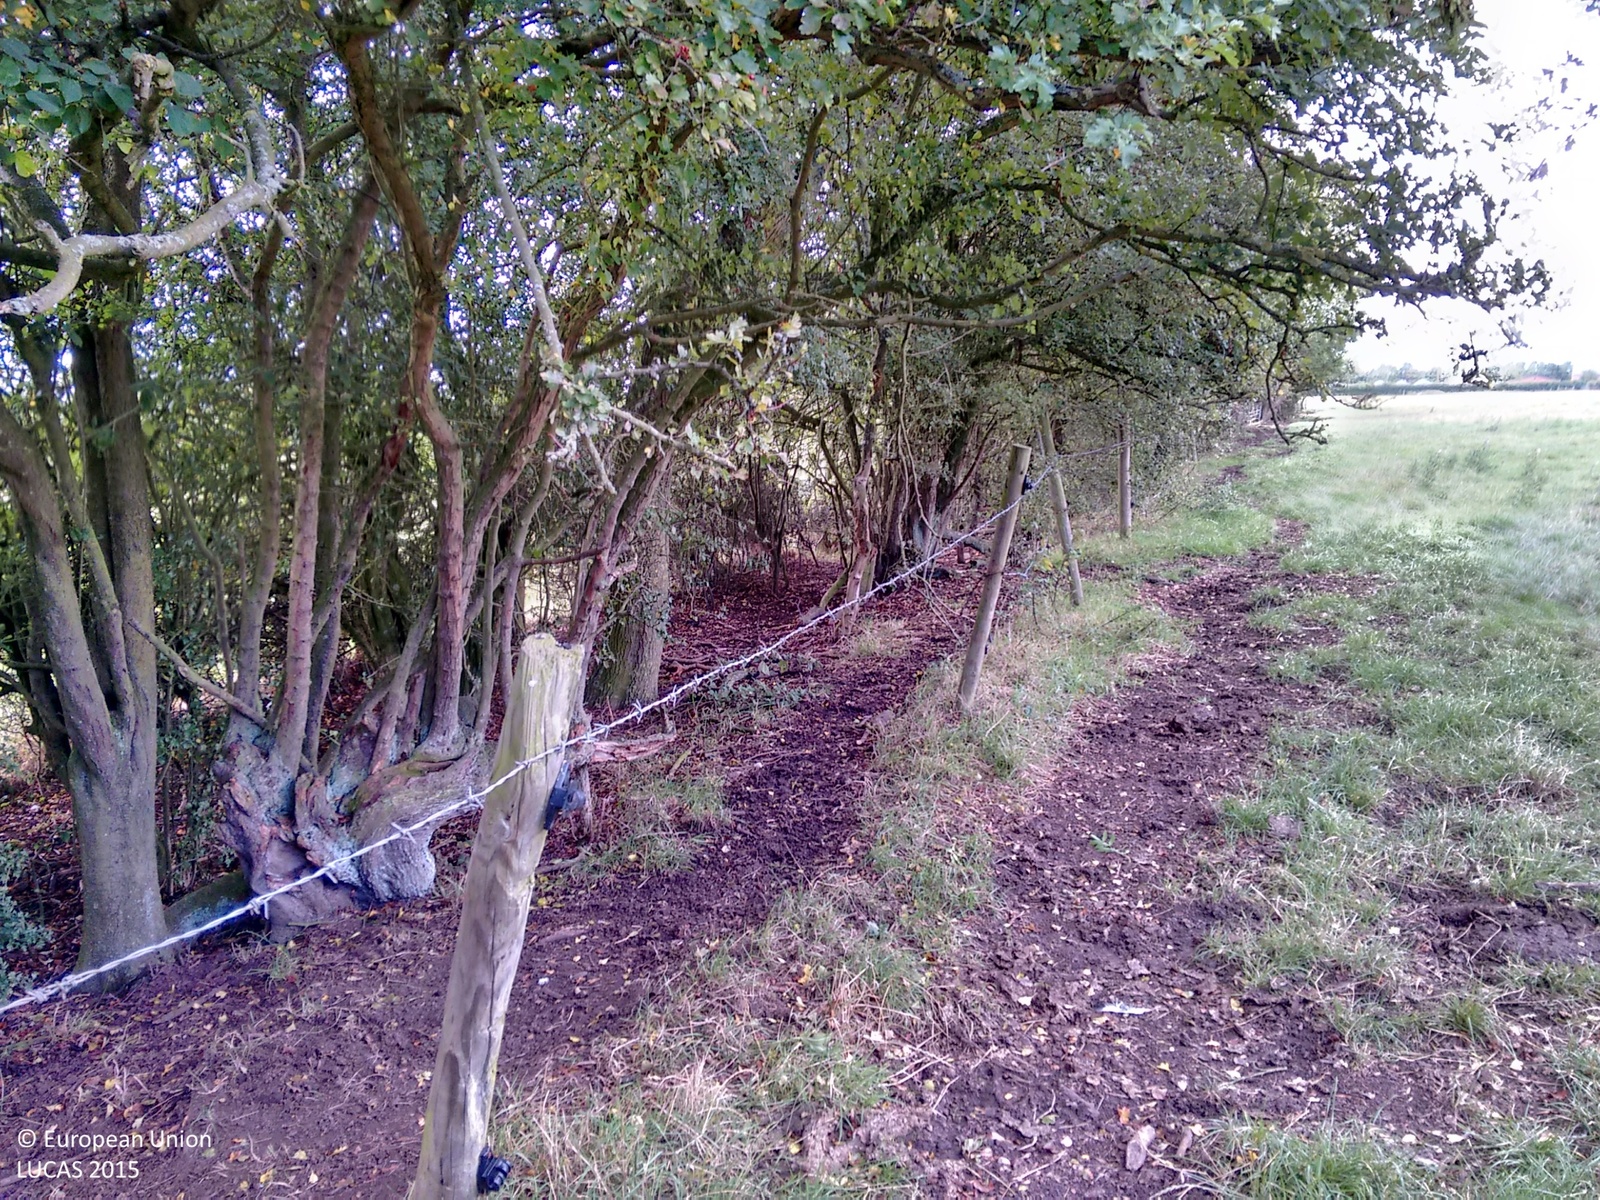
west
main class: Grassland
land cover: Grassland without tree/shrub cover
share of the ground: > 75 %
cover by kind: herbaceous plants 100 %
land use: Agriculture (excluding fallow land and kitchen gardens)
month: September
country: GB
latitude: 52.5881
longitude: -1.2206
